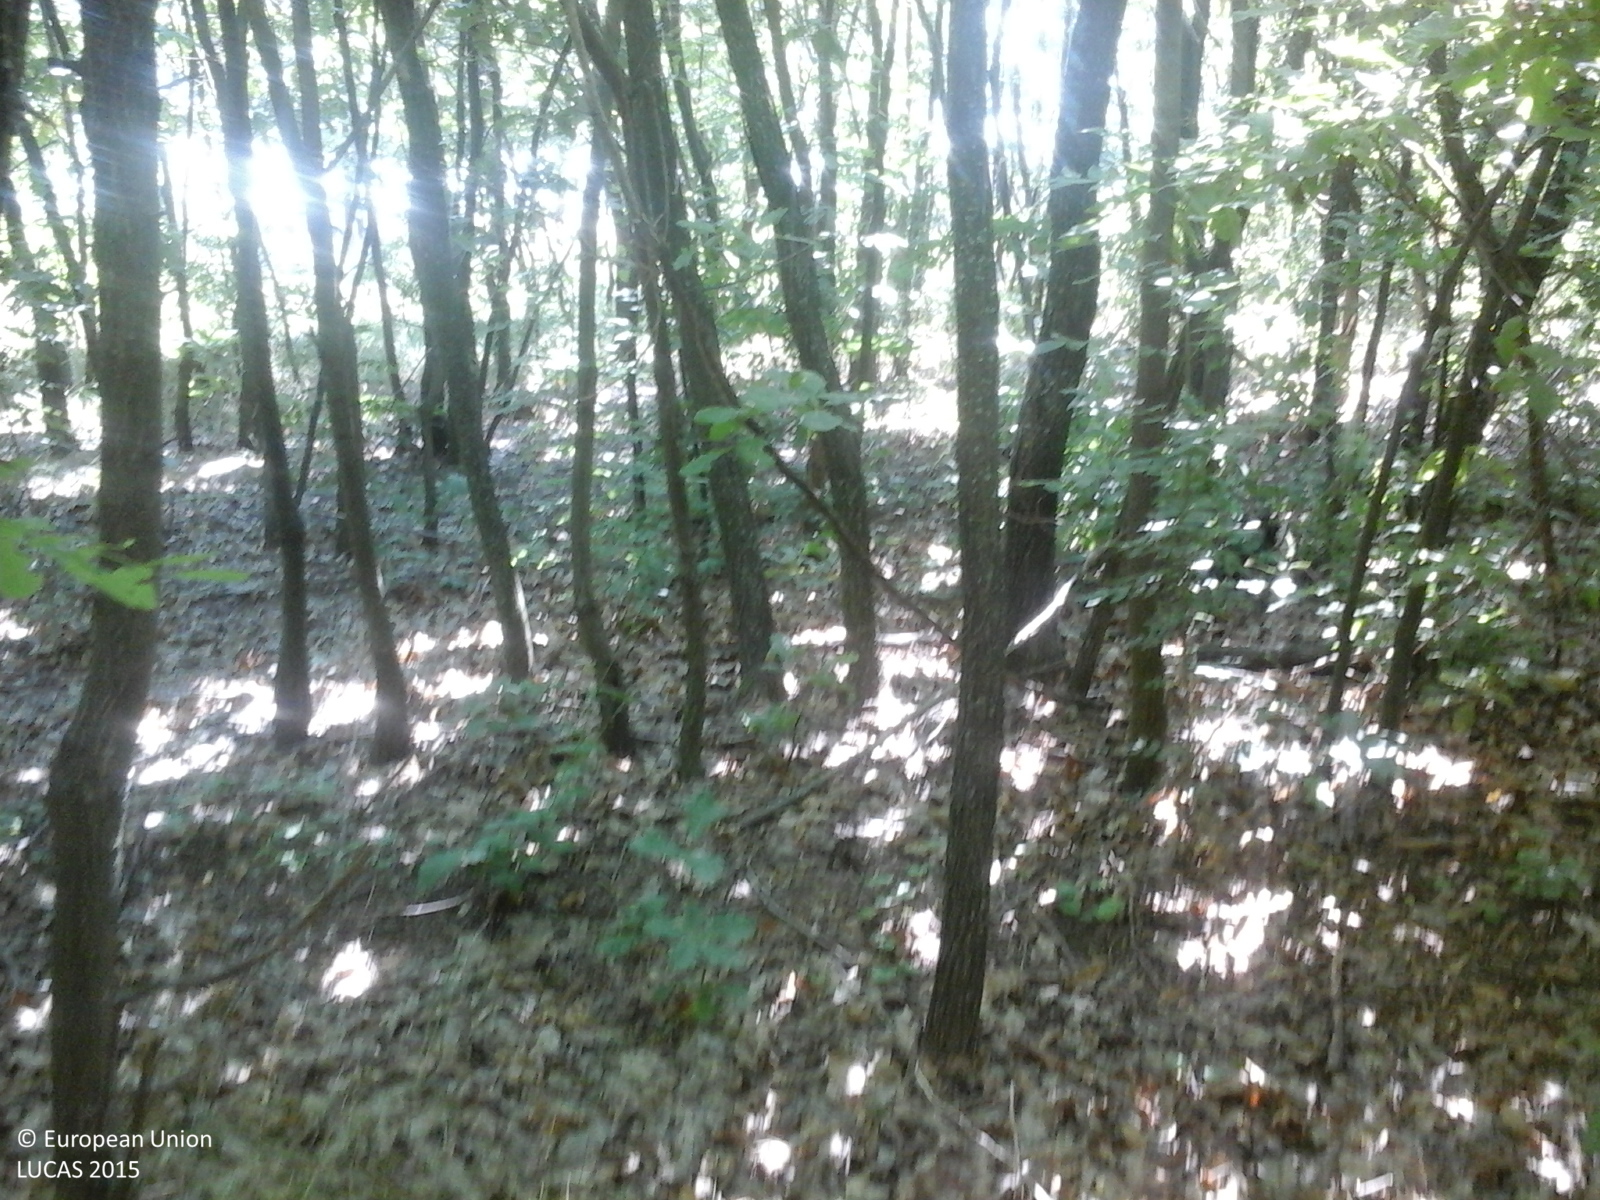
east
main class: Woodland
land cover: Broadleaved woodland
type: mesophytic deciduous forest
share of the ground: > 75 %
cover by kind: broadleaved forest trees 90 %, shrubs 5 %, herbaceous plants 5 %
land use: Forestry
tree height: > 5 m
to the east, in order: Broadleaved woodland; Grass margins; Tracks; Grass margins; Rape and turnip rape
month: July
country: RO
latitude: 44.2683
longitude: 24.5645
